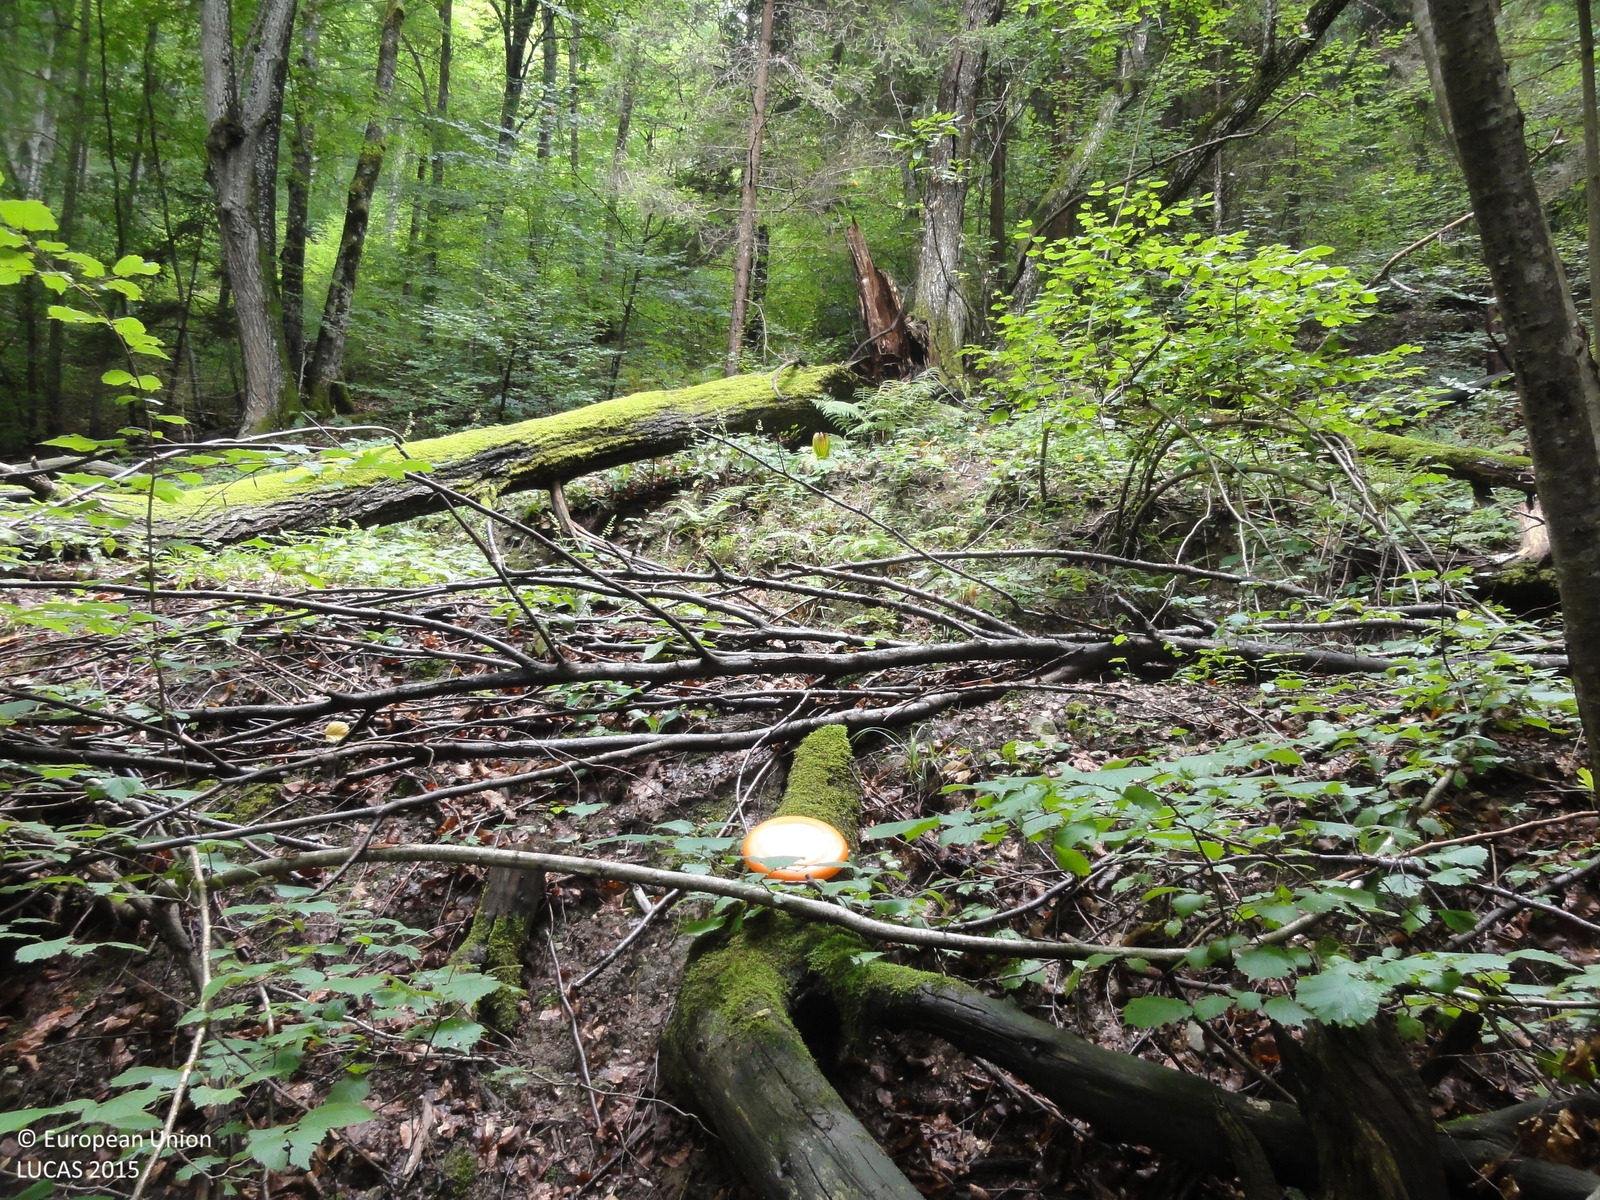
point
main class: Woodland
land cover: Broadleaved woodland
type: beech forest
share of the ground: > 75 %
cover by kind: broadleaved forest trees 90 %, coniferous forest trees 10 %
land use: Forestry
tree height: > 5 m
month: August
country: SI
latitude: 45.6704
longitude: 15.0922
